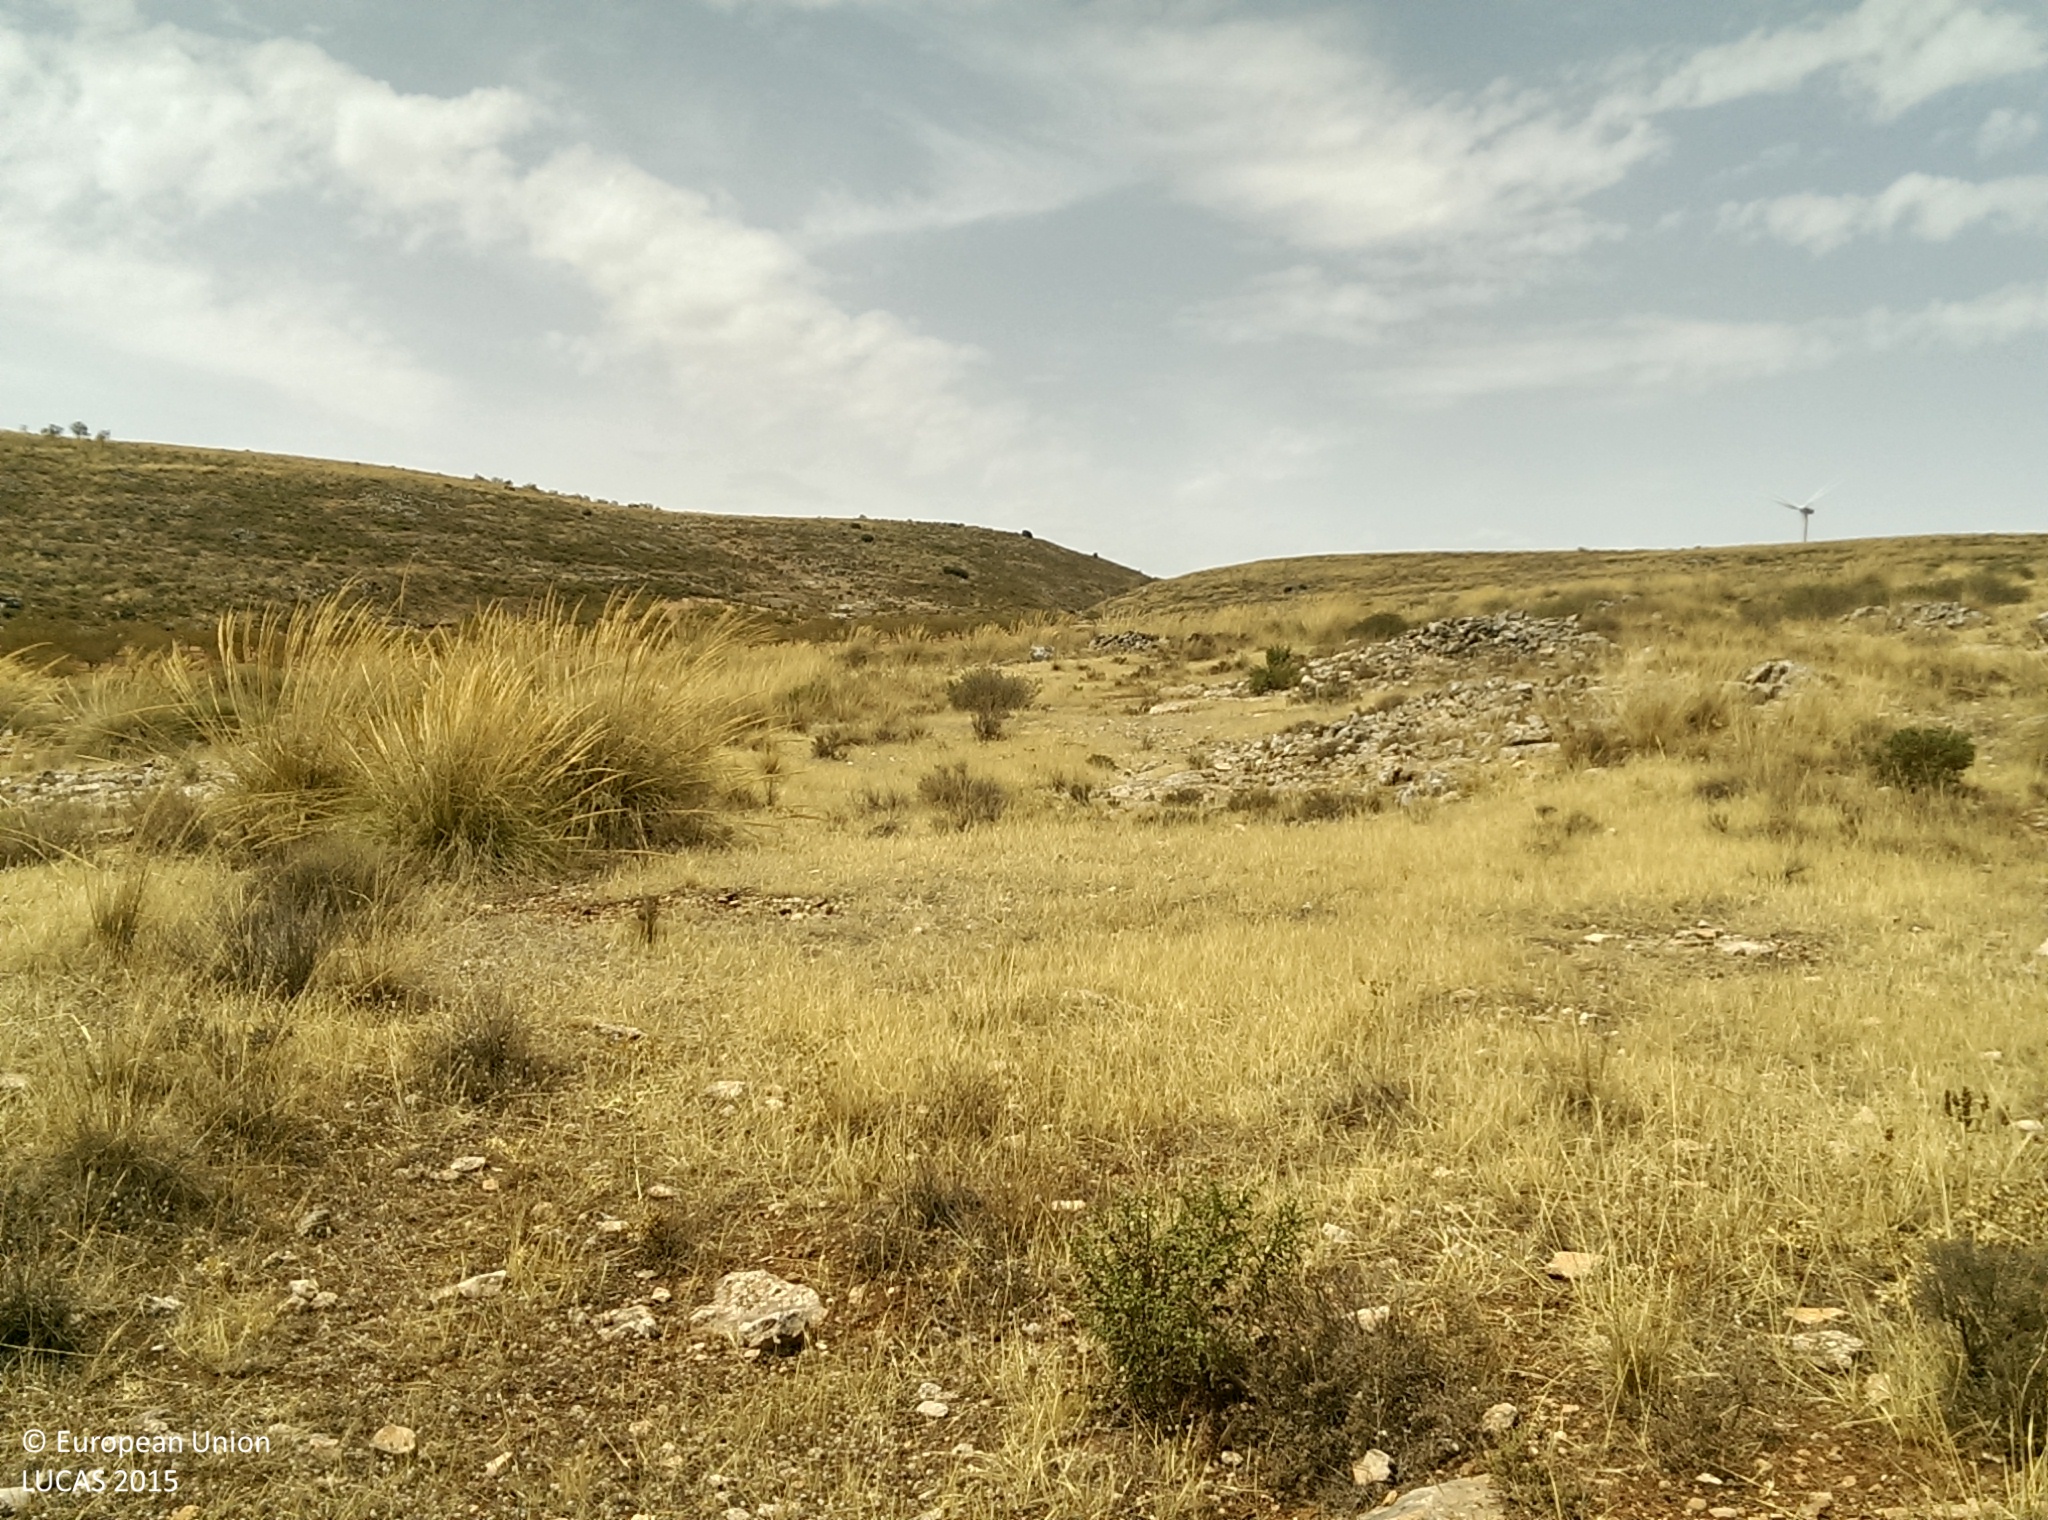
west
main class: Grassland
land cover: Grassland without tree/shrub cover
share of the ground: 50 - 75 %
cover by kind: herbaceous plants 75 %, consolidated bare surface 15 %, unconsolidated bare surface 10 %
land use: Abandoned areas
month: August
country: ES
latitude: 37.0132
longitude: -3.6650
